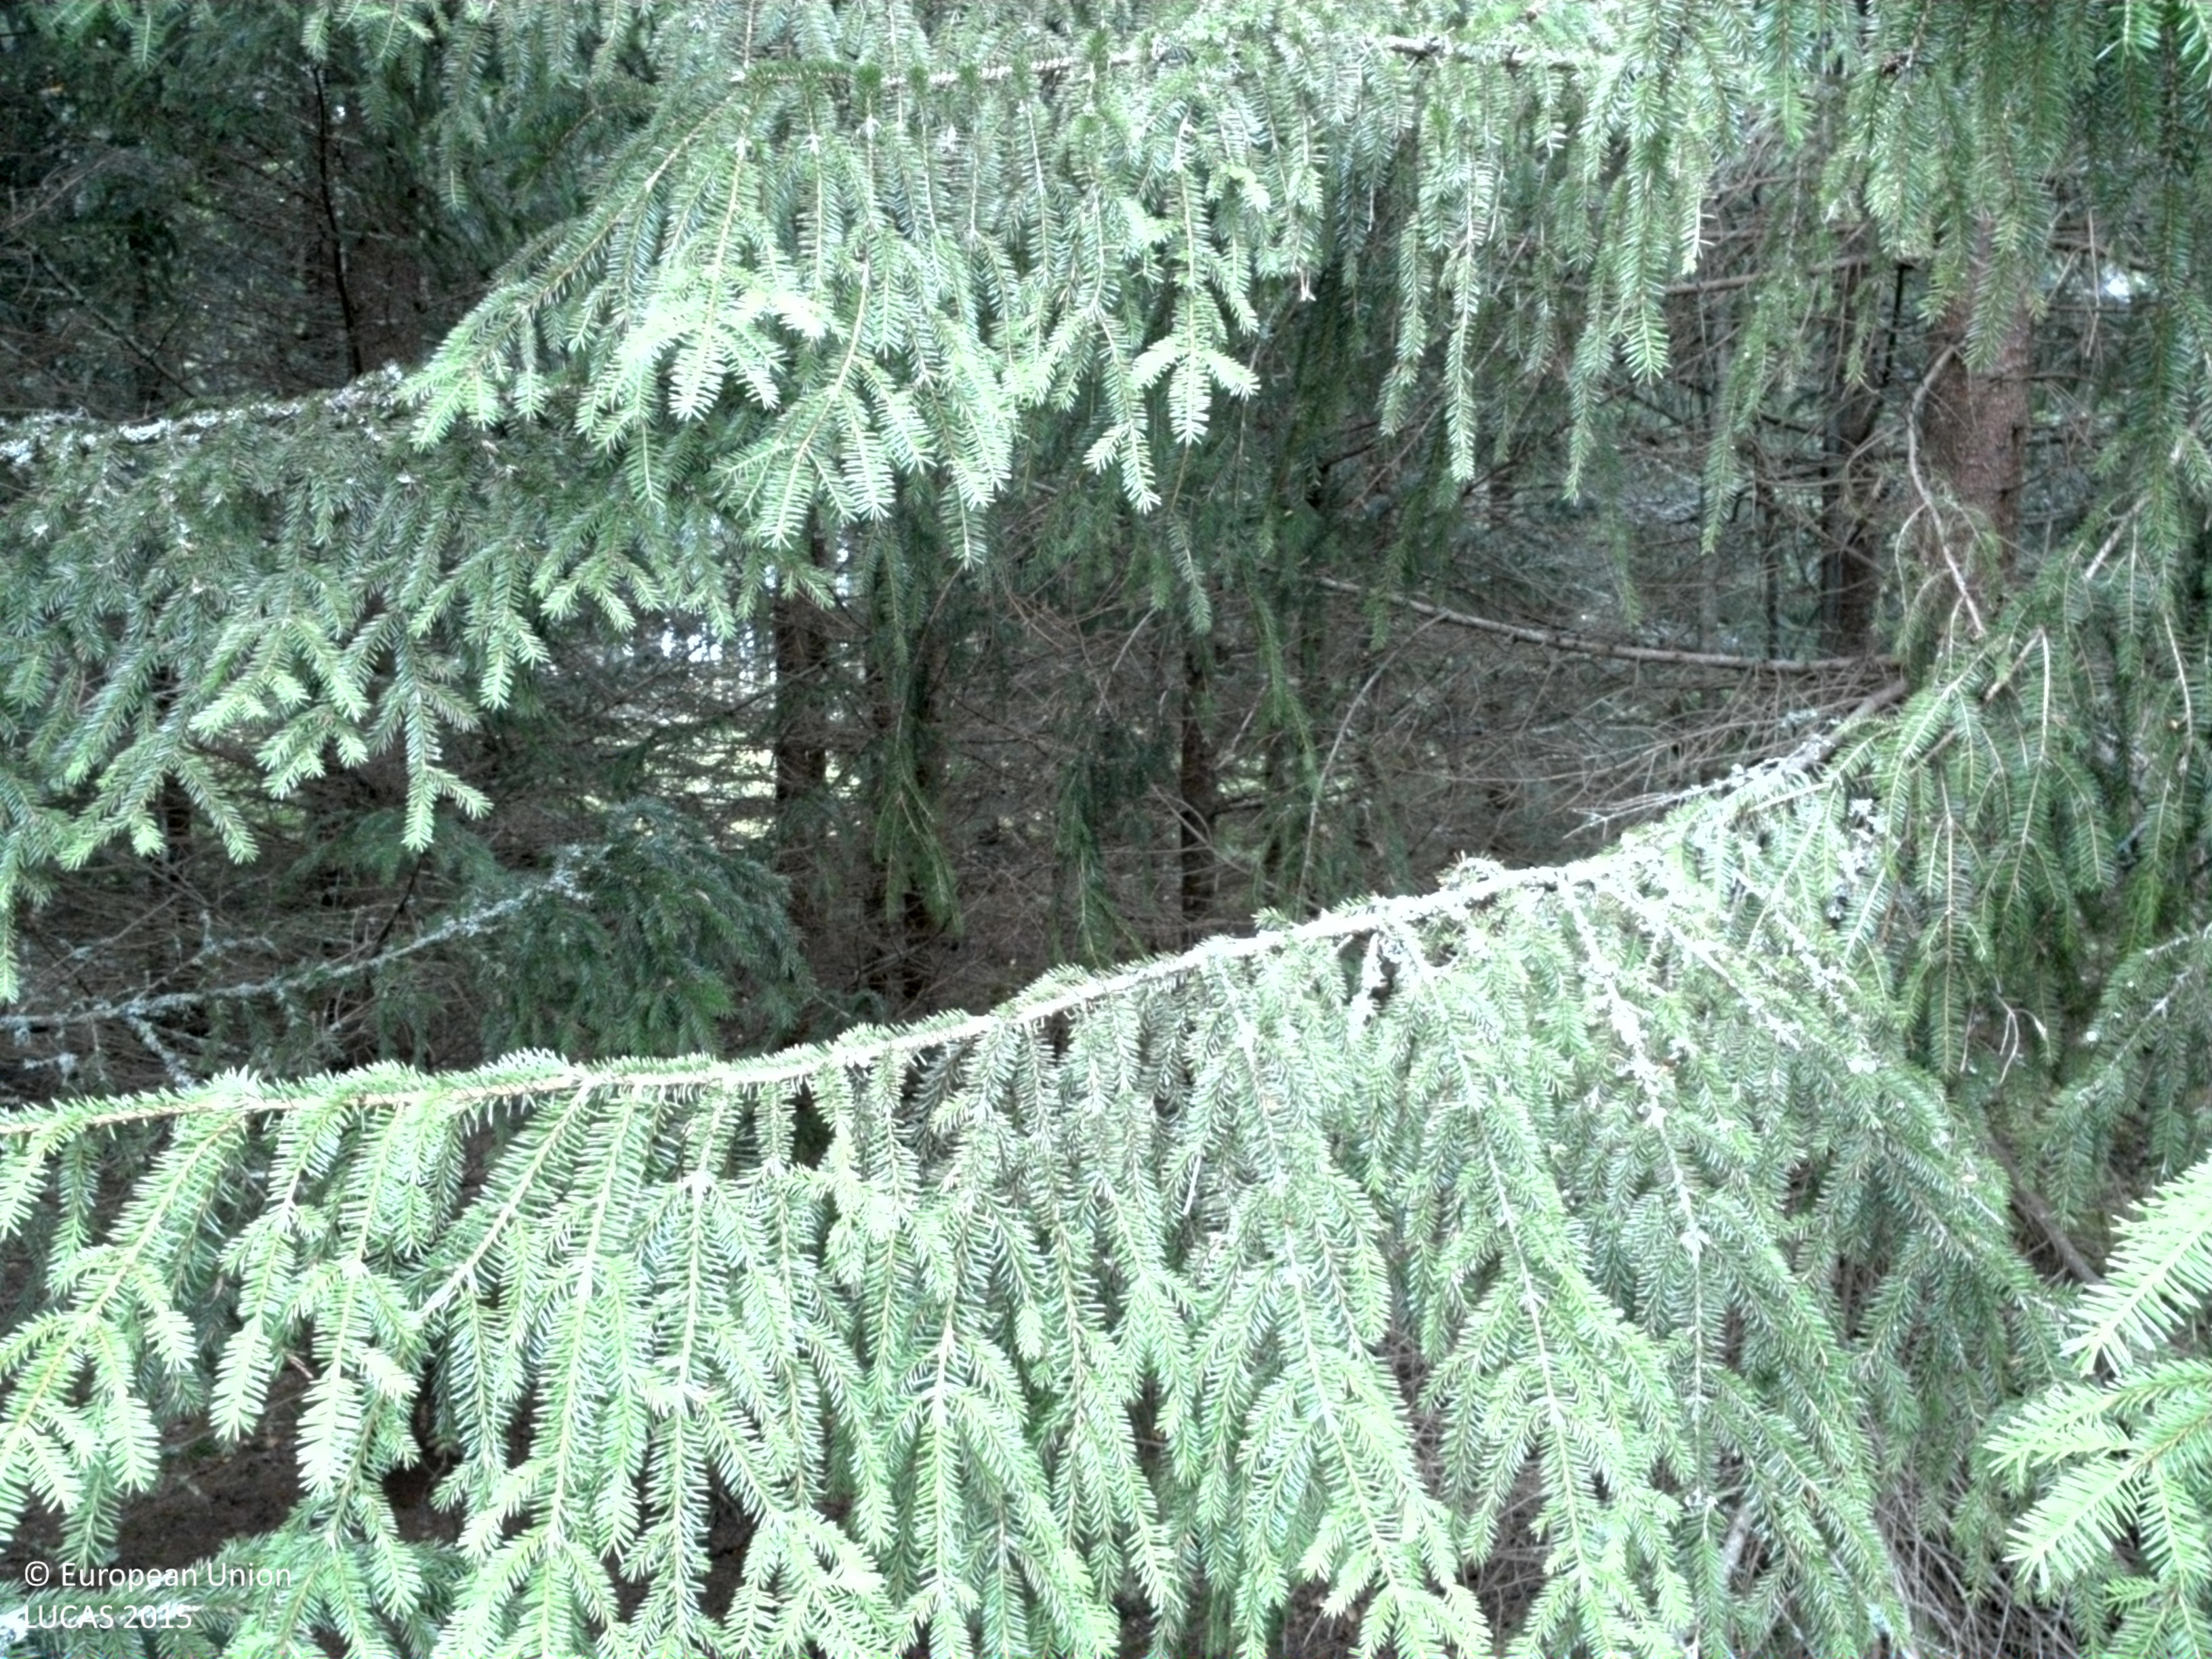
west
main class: Woodland
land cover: Spruce dominated coniferous woodland
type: boreal forest
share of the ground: 50 - 75 %
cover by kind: coniferous forest trees 65 %, broadleaved forest trees 10 %, herbaceous plants 10 %, lichens and mosses 10 %, shrubs 5 %
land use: Forestry
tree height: > 5 m
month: August
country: SE
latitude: 59.8678
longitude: 16.5096
